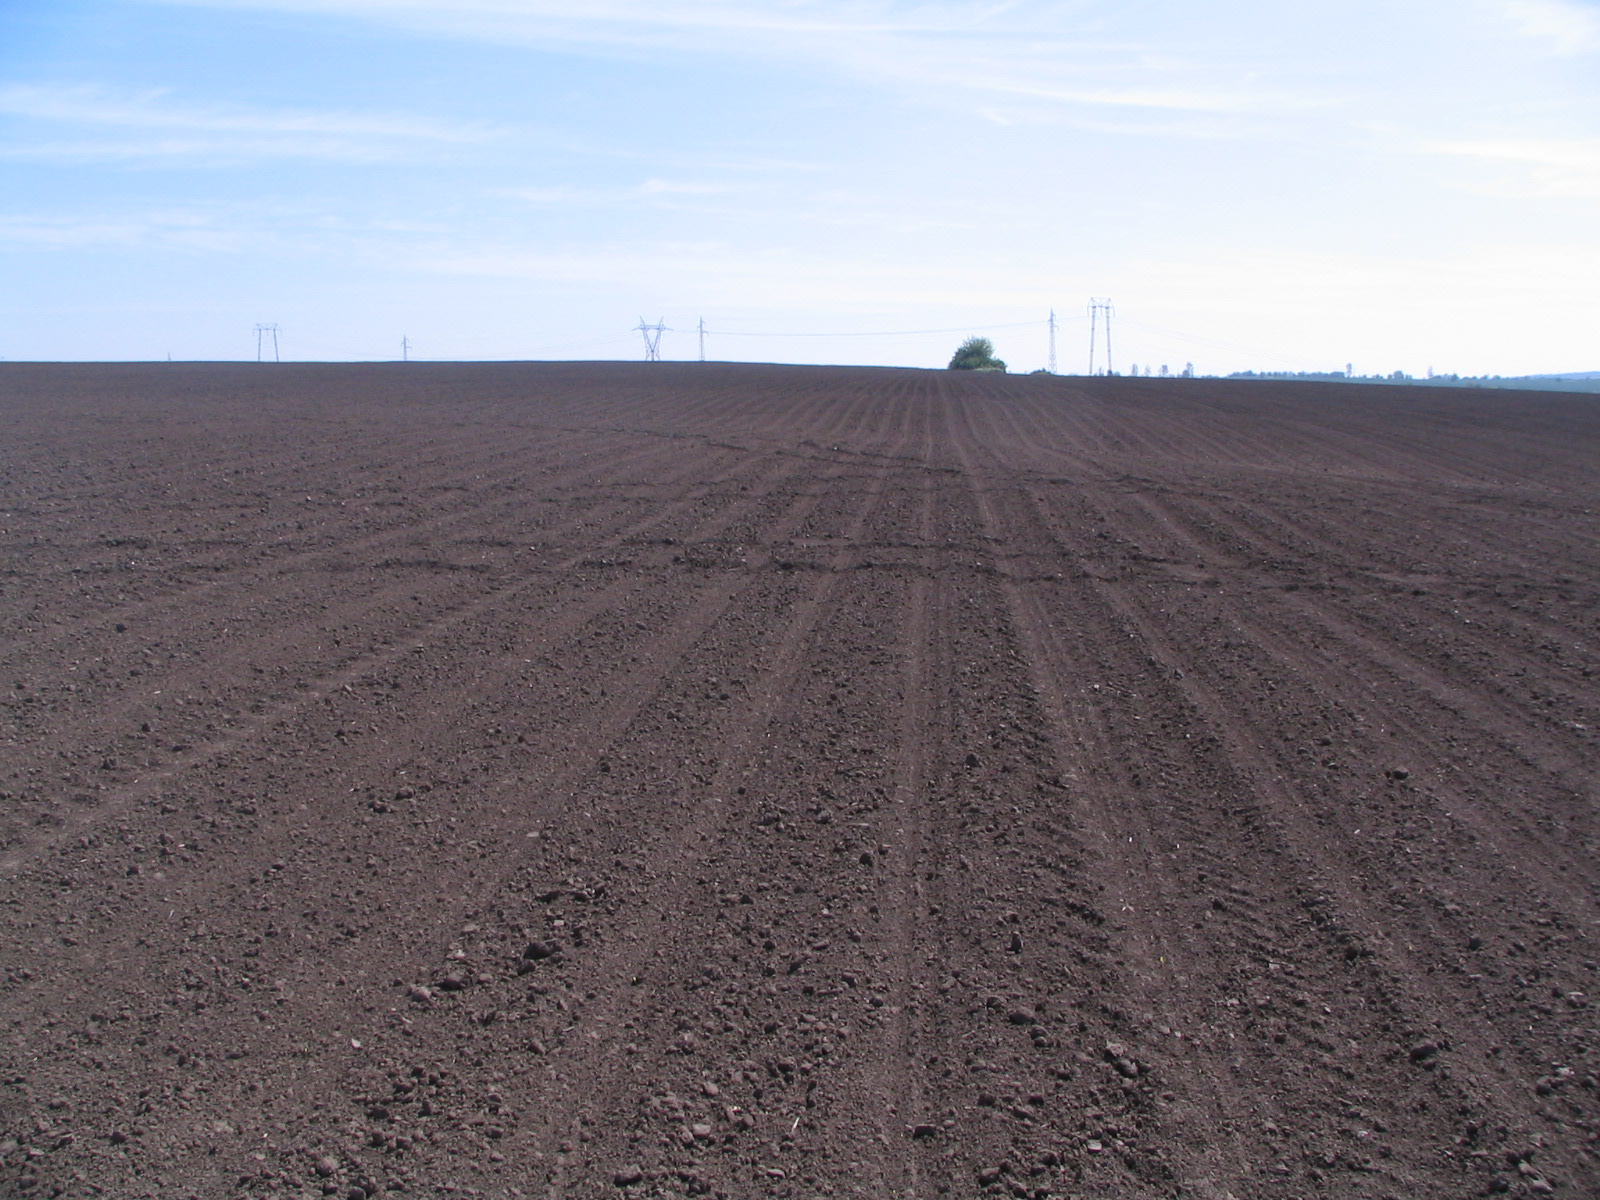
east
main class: Cropland
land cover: Maize
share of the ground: < 10 %
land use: Agriculture (excluding fallow land and kitchen gardens)
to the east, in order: Maize
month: May
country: BG
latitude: 43.7181
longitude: 23.9179
